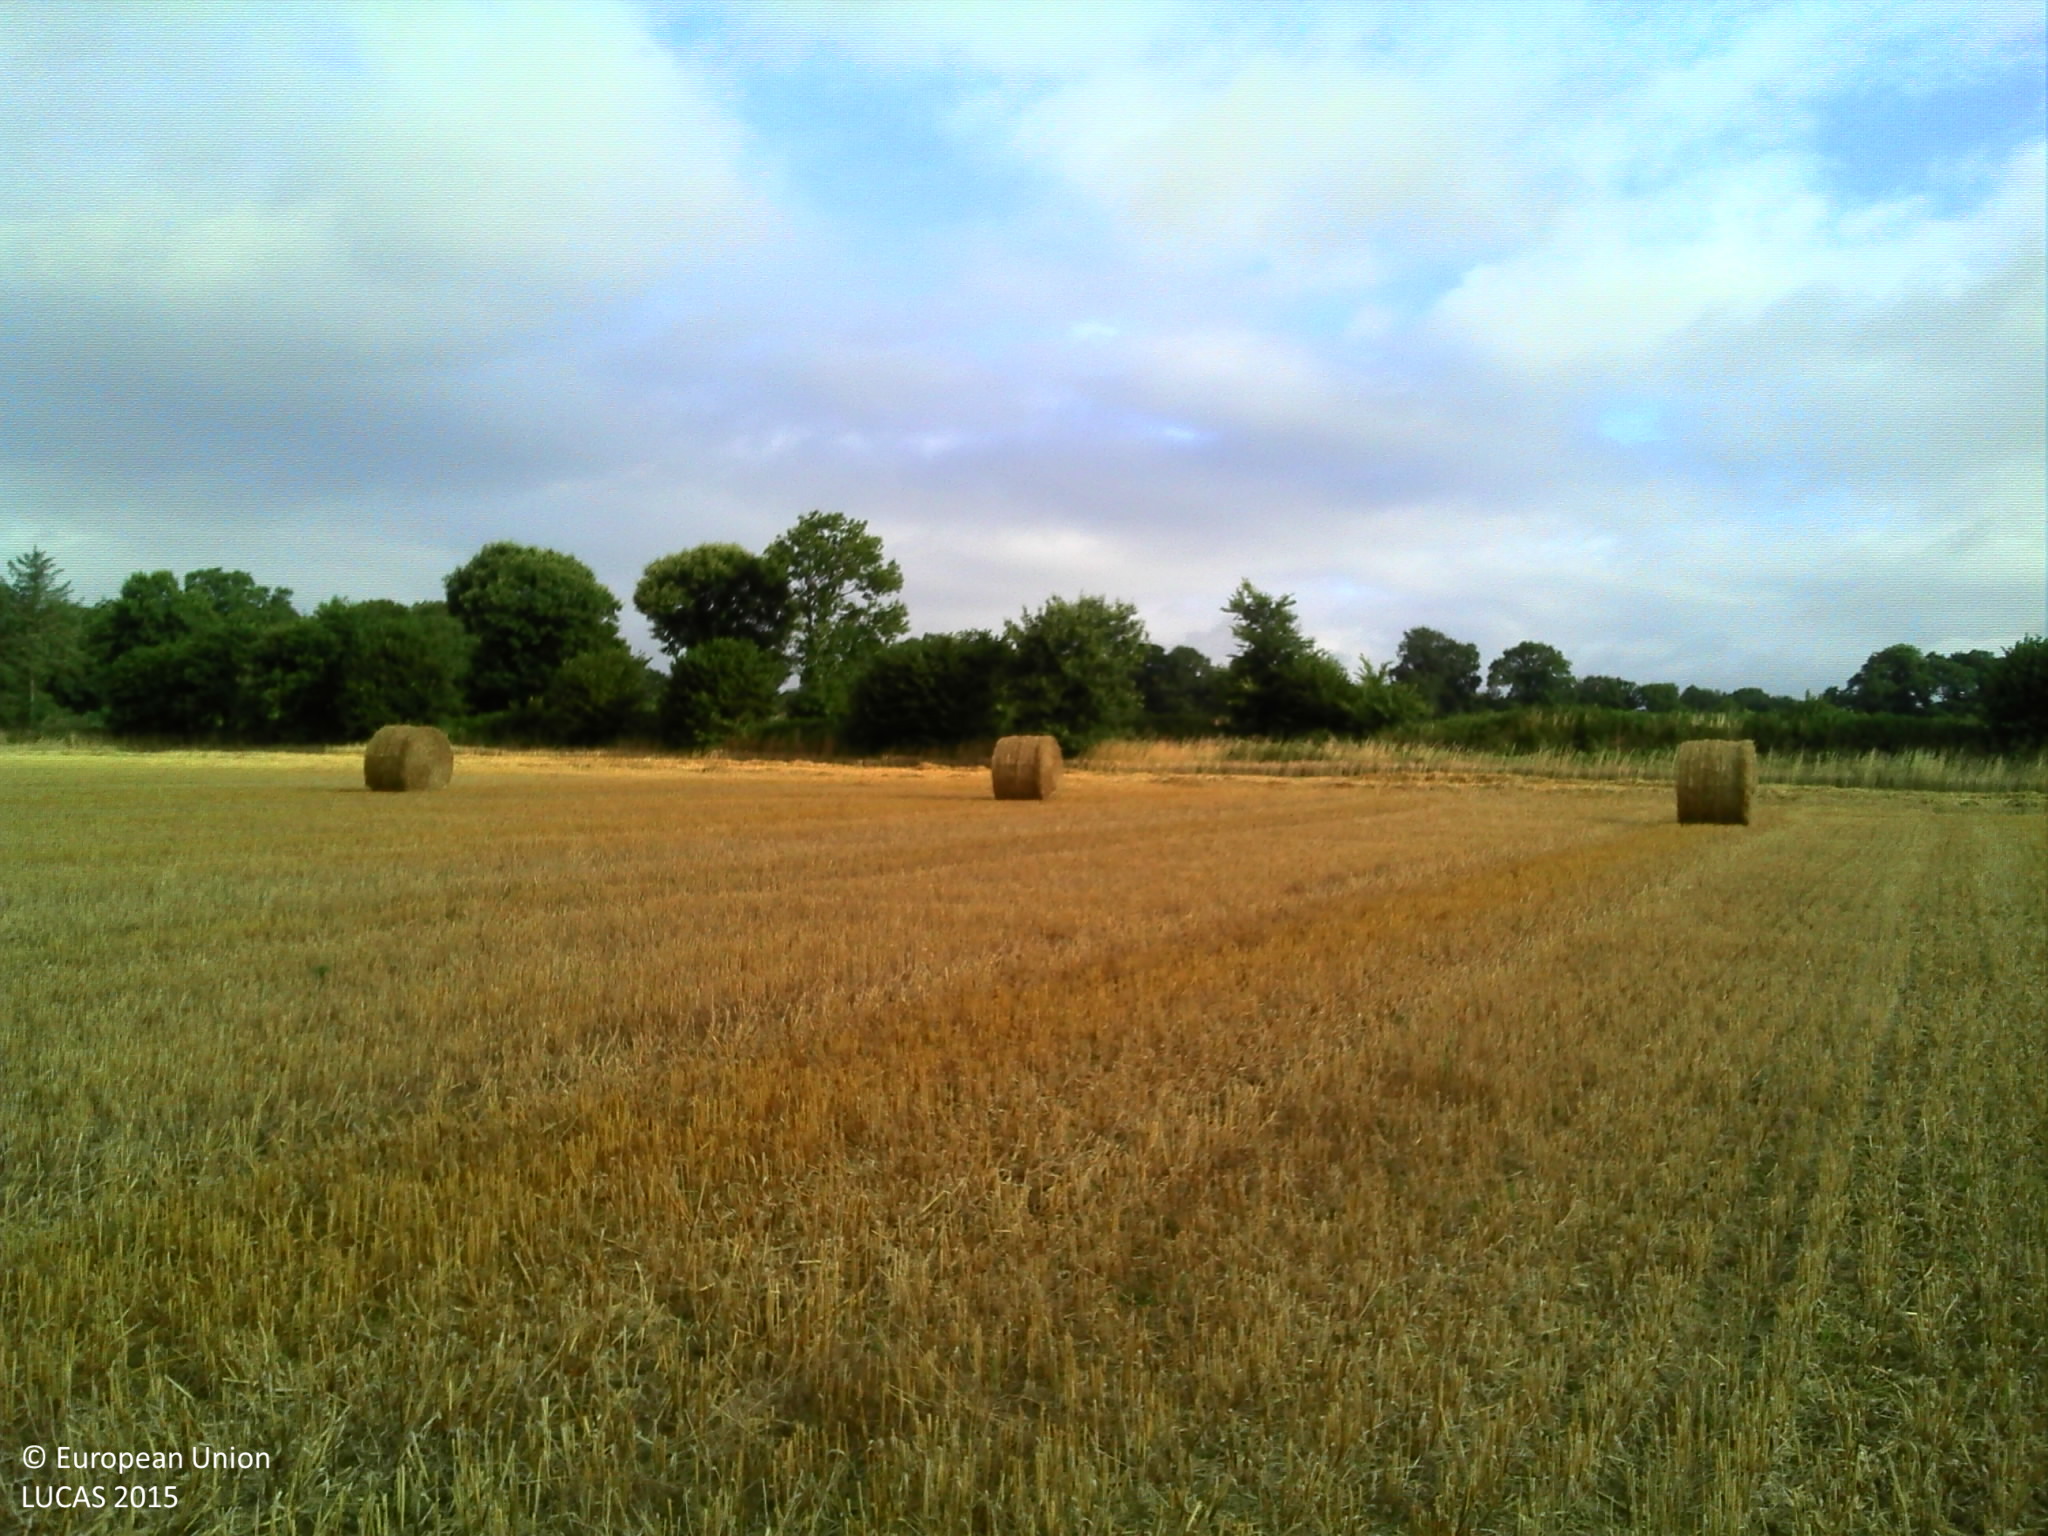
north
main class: Cropland
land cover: Common wheat
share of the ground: > 75 %
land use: Agriculture (excluding fallow land and kitchen gardens)
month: August
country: FR
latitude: 48.2824
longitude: -3.0474
